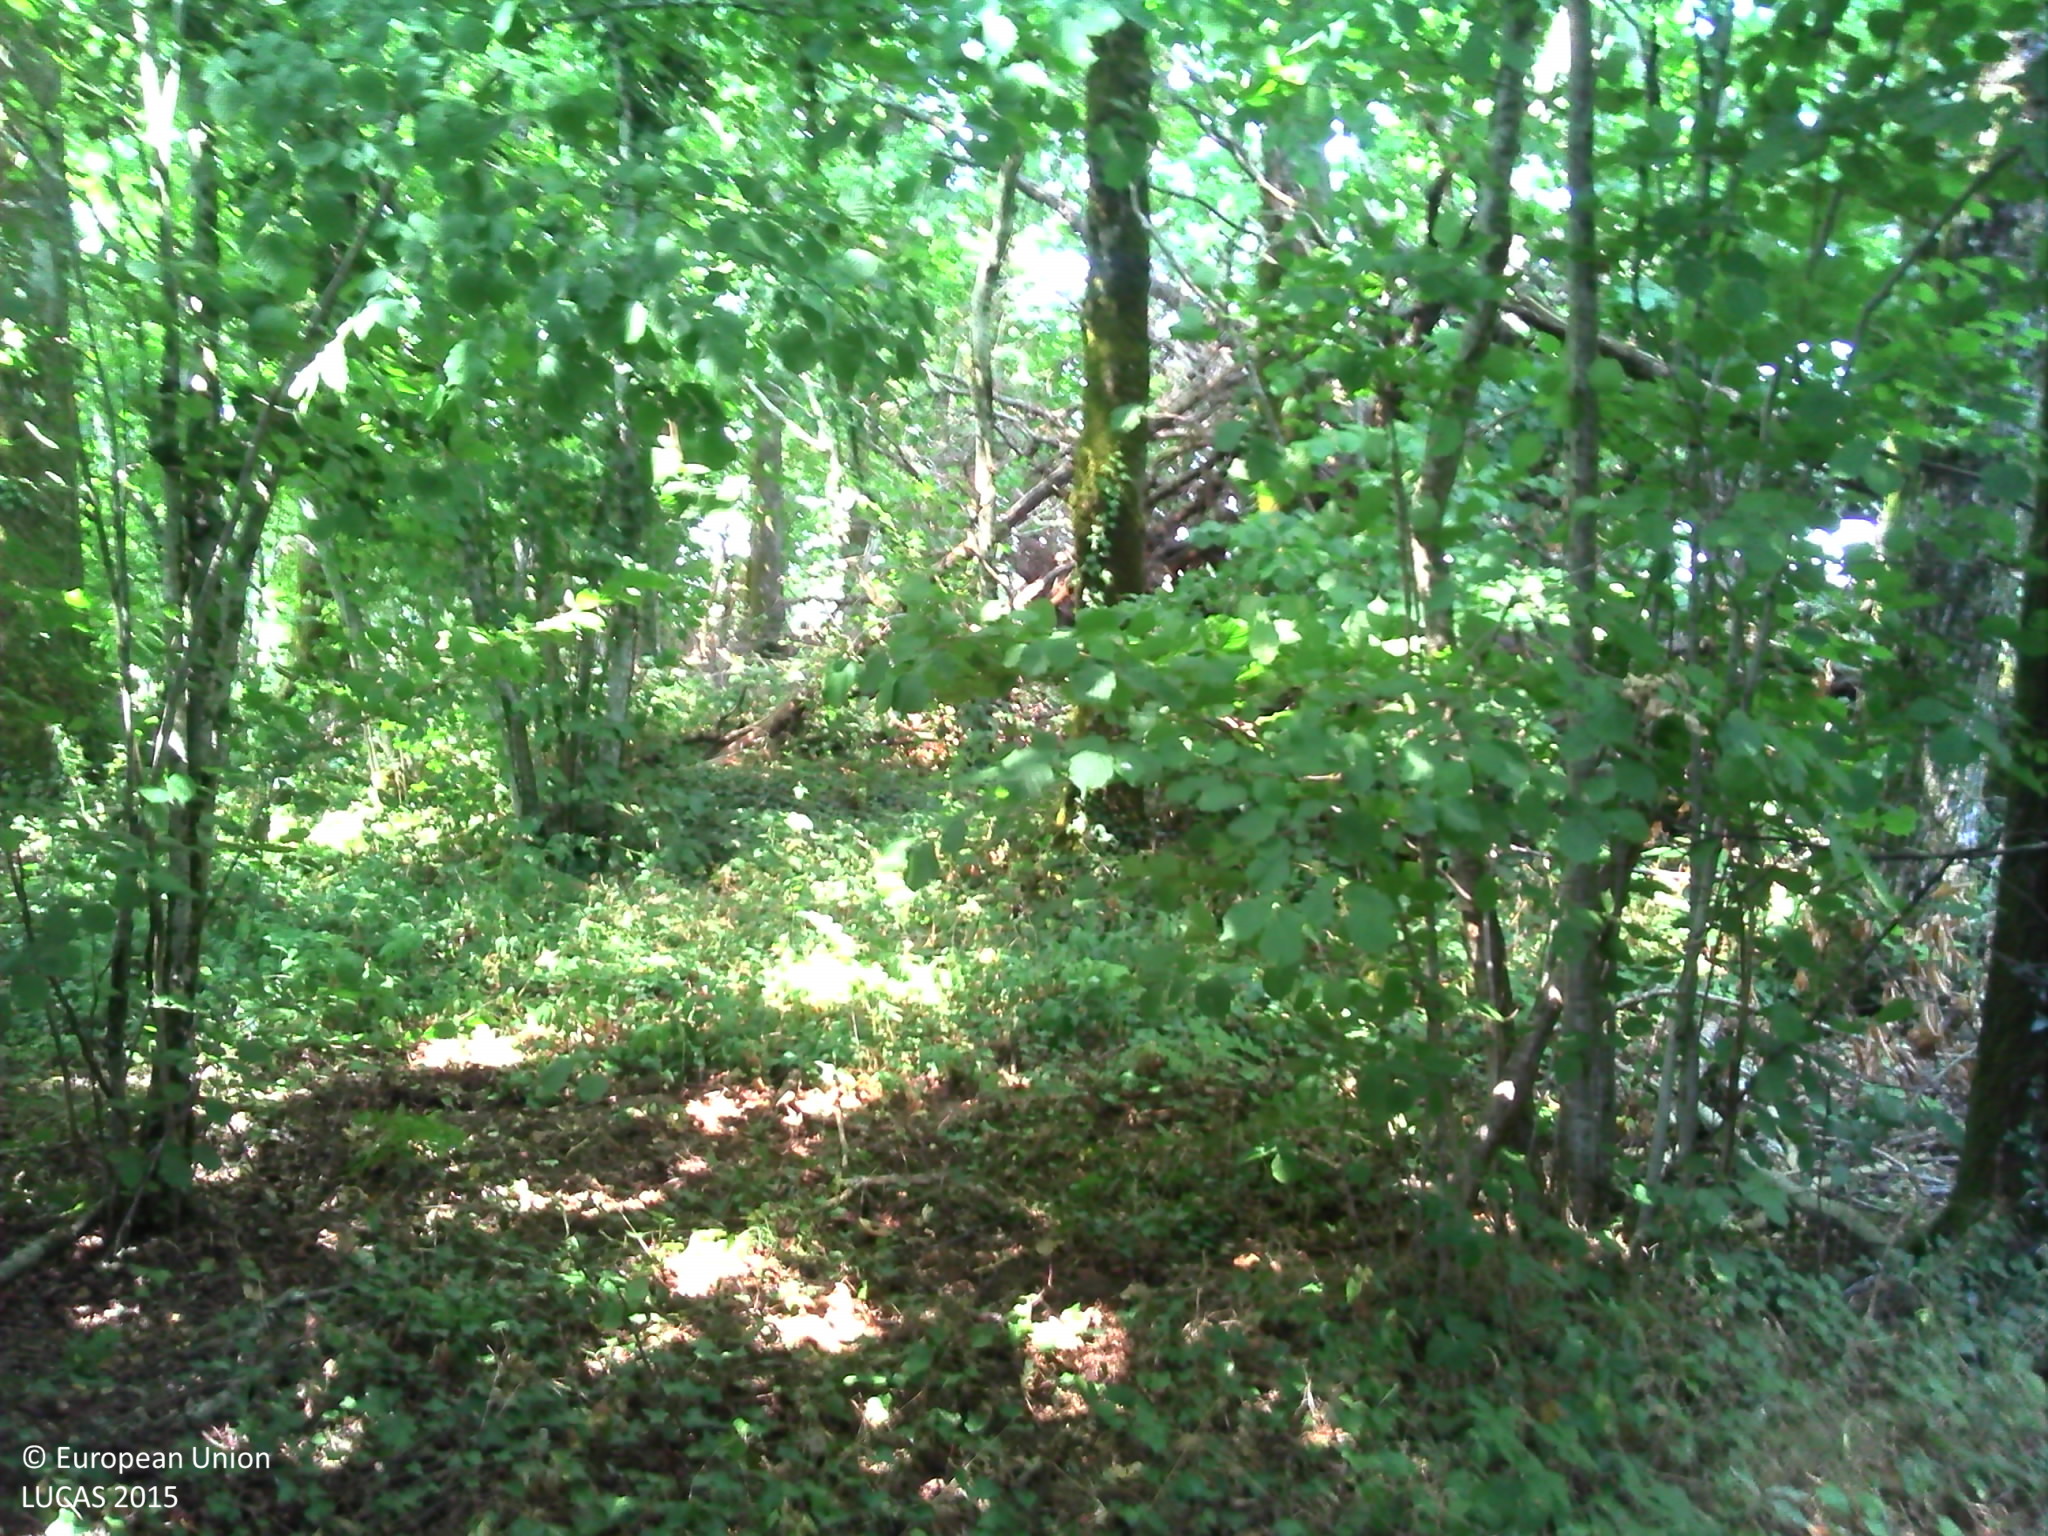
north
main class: Woodland
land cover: Broadleaved woodland
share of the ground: > 75 %
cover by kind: broadleaved forest trees 40 %, herbaceous plants 20 %, lichens and mosses 20 %, unconsolidated bare surface 20 %
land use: Forestry
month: July
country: FR
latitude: 45.6446
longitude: 0.9957
